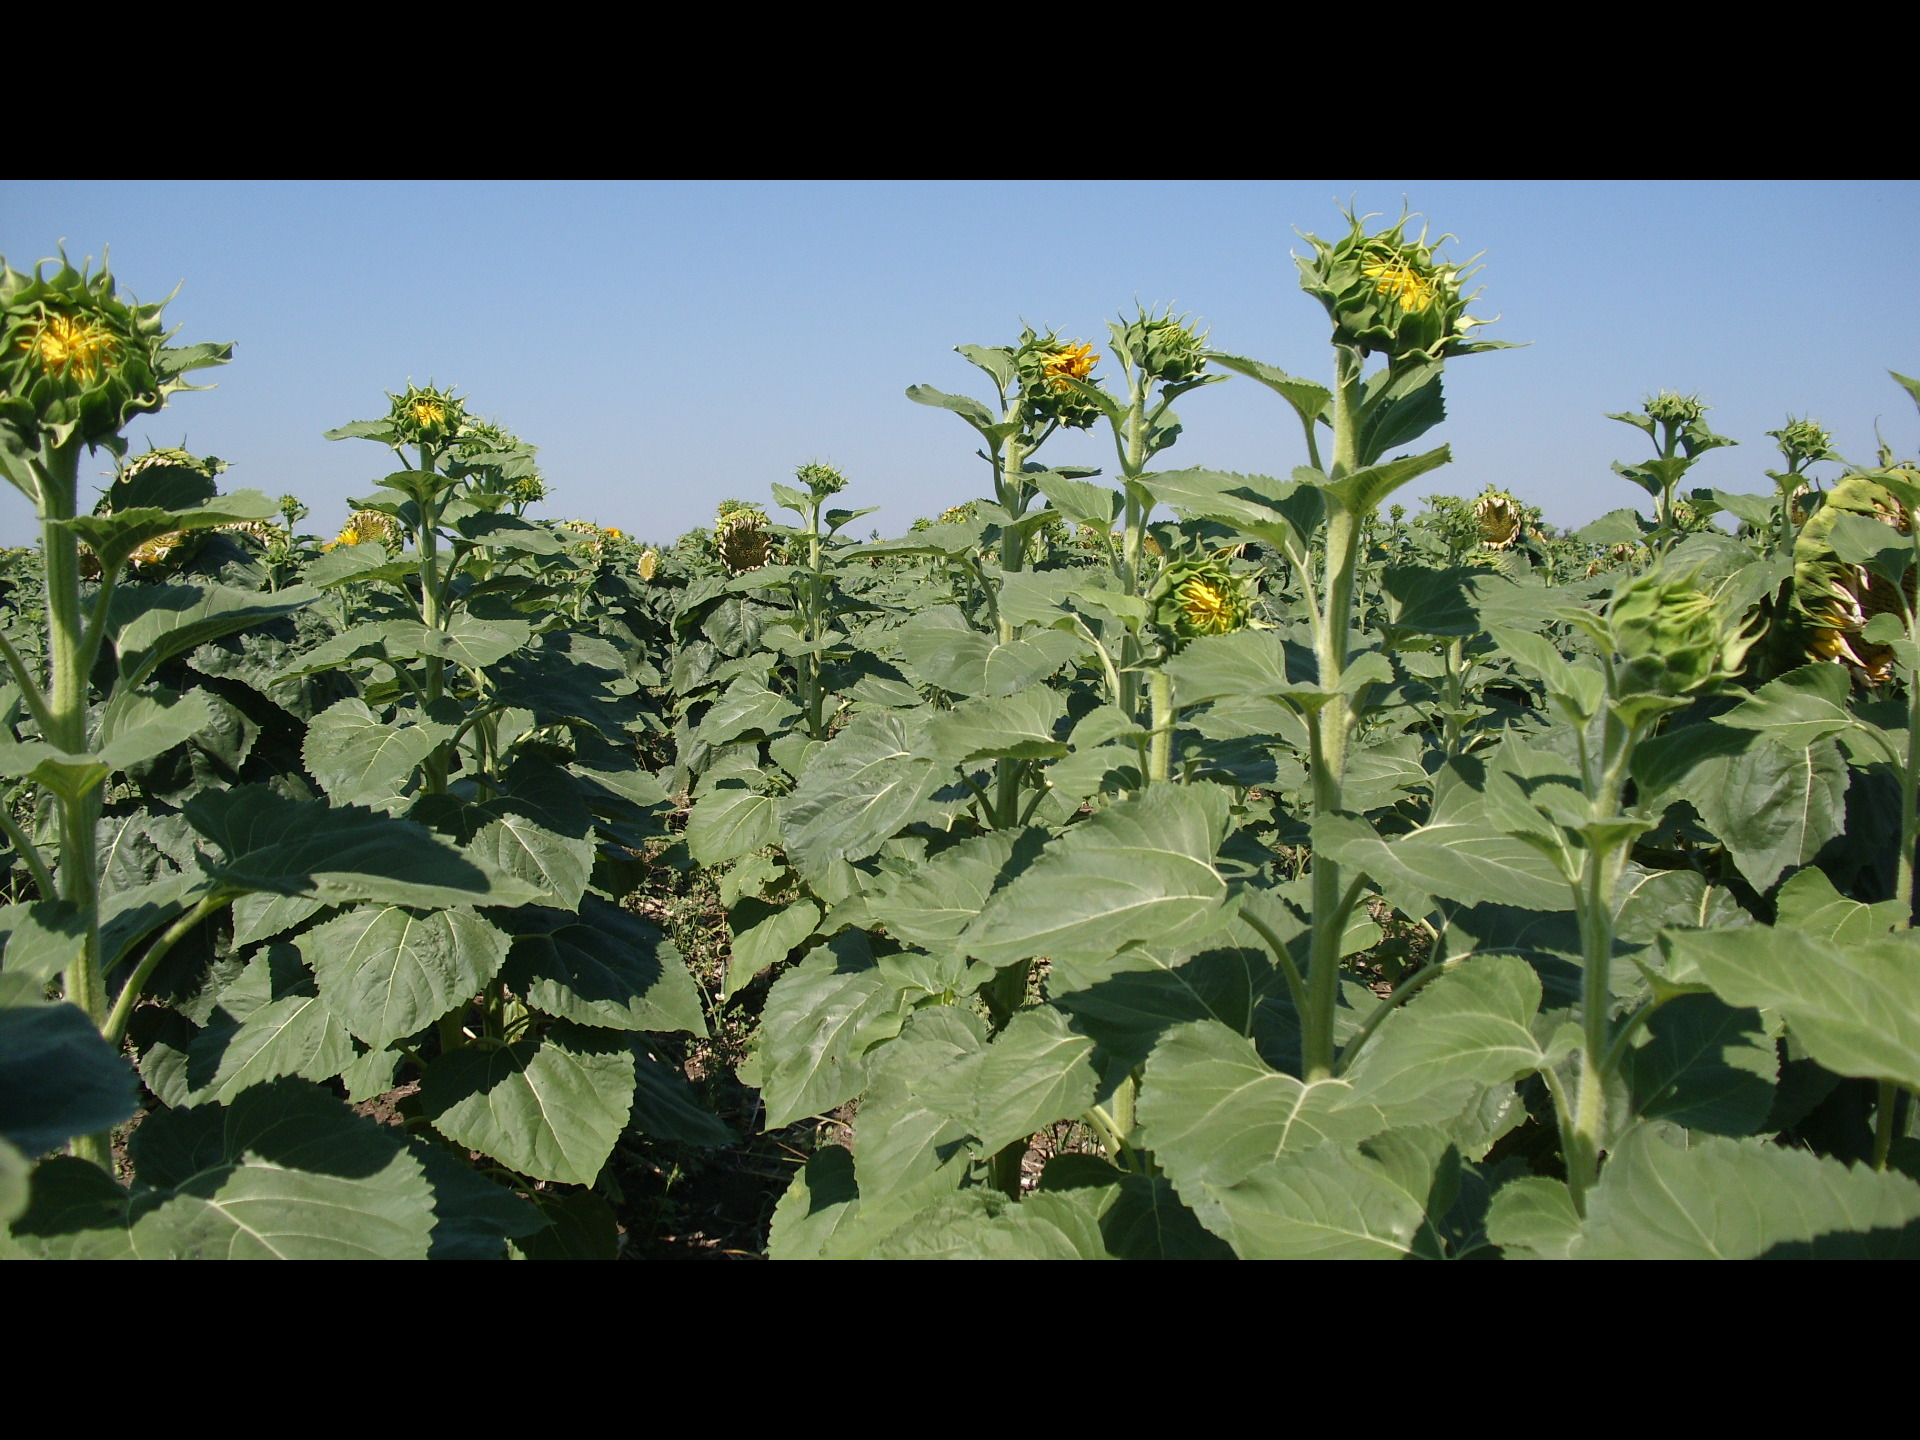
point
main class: Cropland
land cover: Sunflower
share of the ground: > 75 %
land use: Agriculture (excluding fallow land and kitchen gardens)
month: July
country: BG
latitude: 43.8660
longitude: 22.6399
